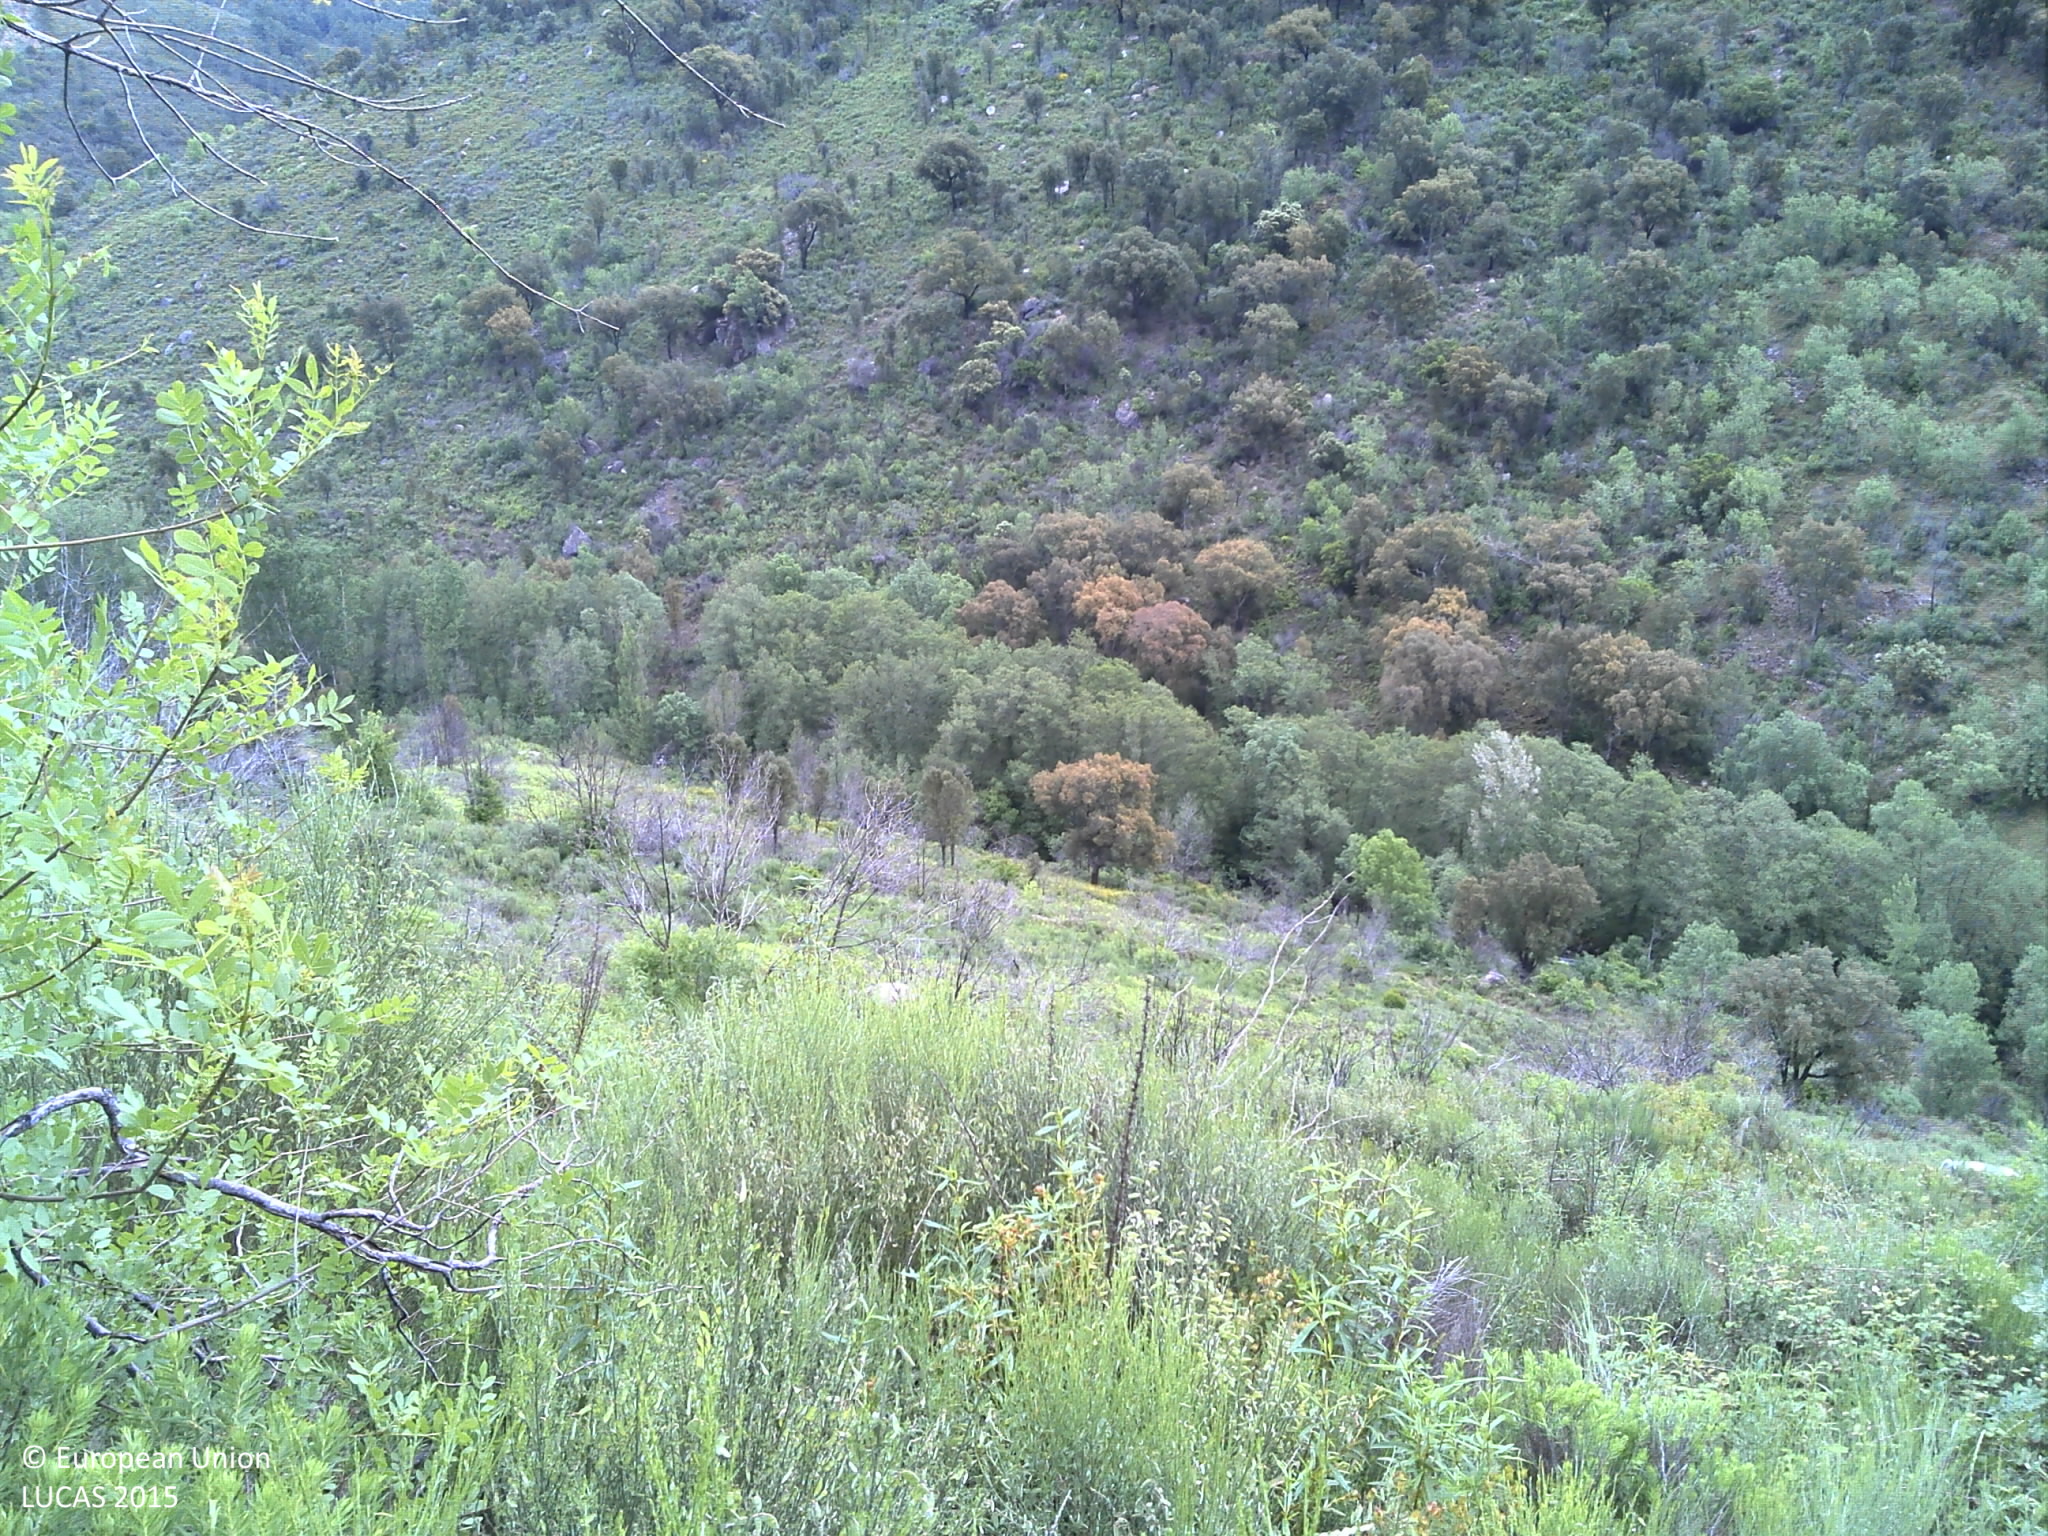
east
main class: Shrubland
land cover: Shrubland with sparse tree cover
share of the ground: > 75 %
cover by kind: shrubs 90 %, broadleaved forest trees 5 %, unconsolidated bare surface 5 %
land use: Forestry
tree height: < 5 m
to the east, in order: Shrubland with sparse tree cover; Tracks; Shrubland without tree cover; Shrubland with sparse tree cover; Tracks; Shrubland with sparse tree cover; Abandoned hedges; Rivers and streams; Abandoned hedges; Broadleaved woodland
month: May
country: PT
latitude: 41.6799
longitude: -7.0197
